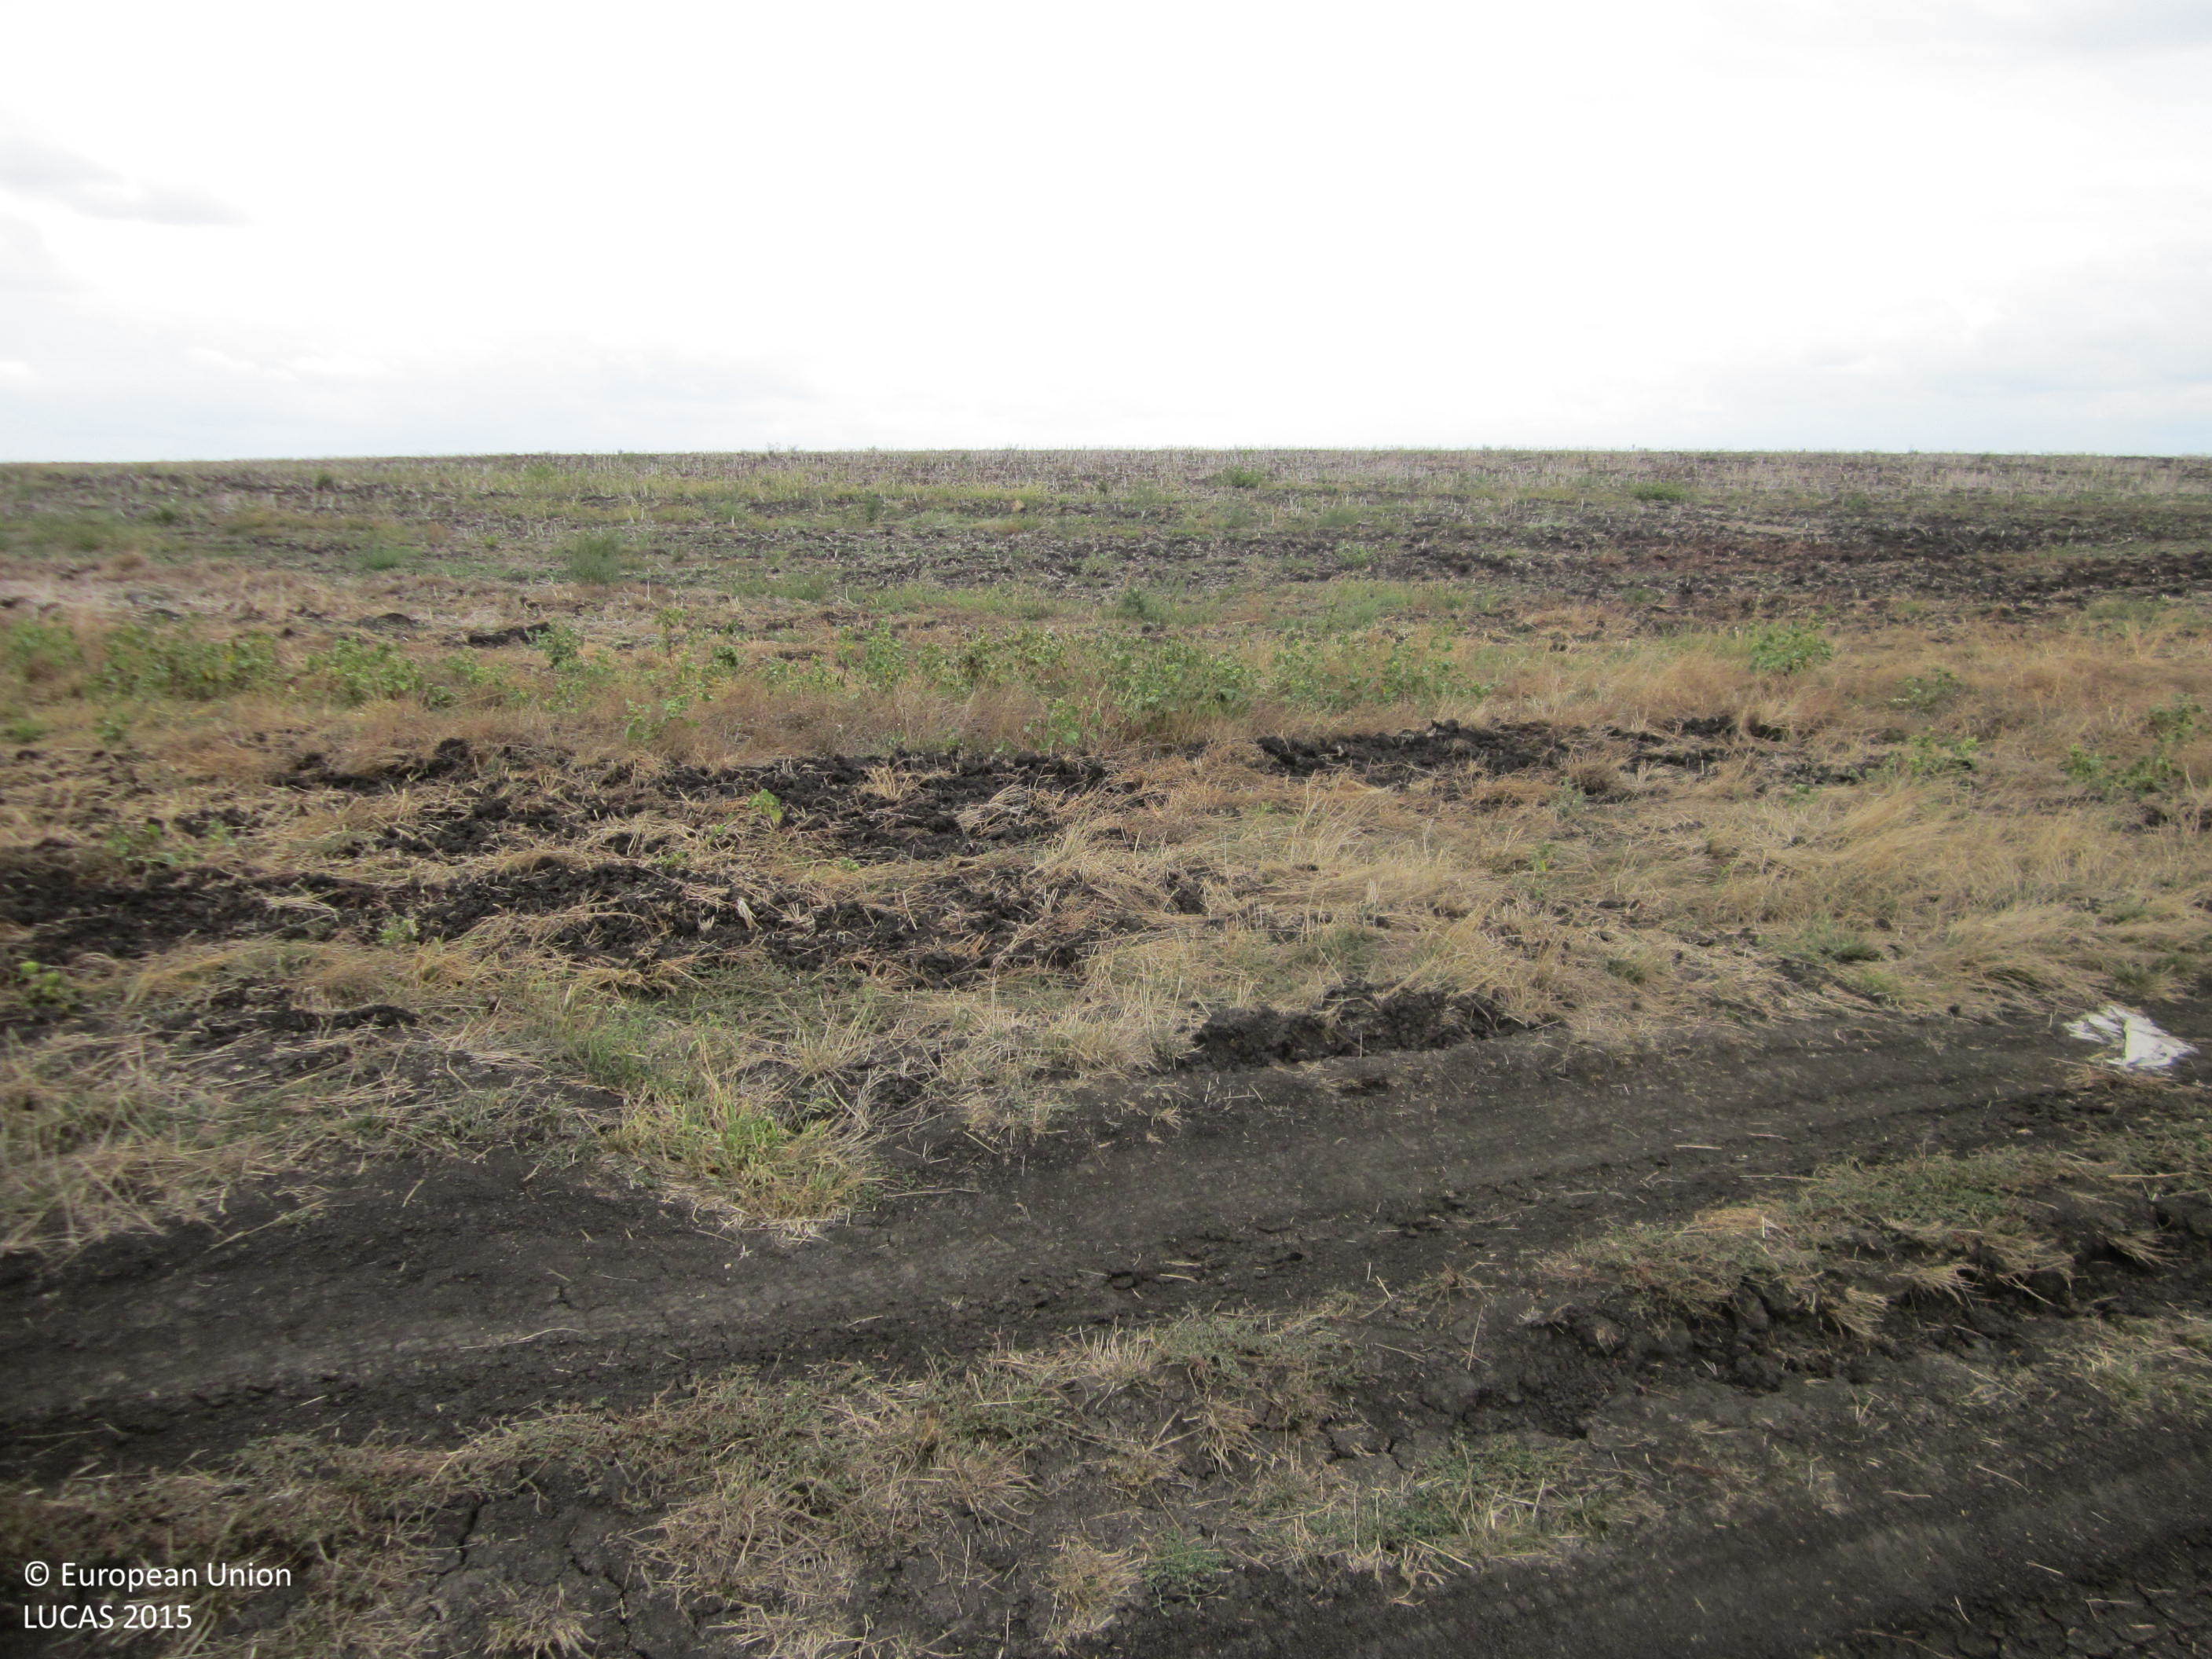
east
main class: Cropland
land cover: Sunflower
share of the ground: > 75 %
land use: Agriculture (excluding fallow land and kitchen gardens)
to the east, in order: Sunflower
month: September
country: BG
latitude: 42.4734
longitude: 27.2239
